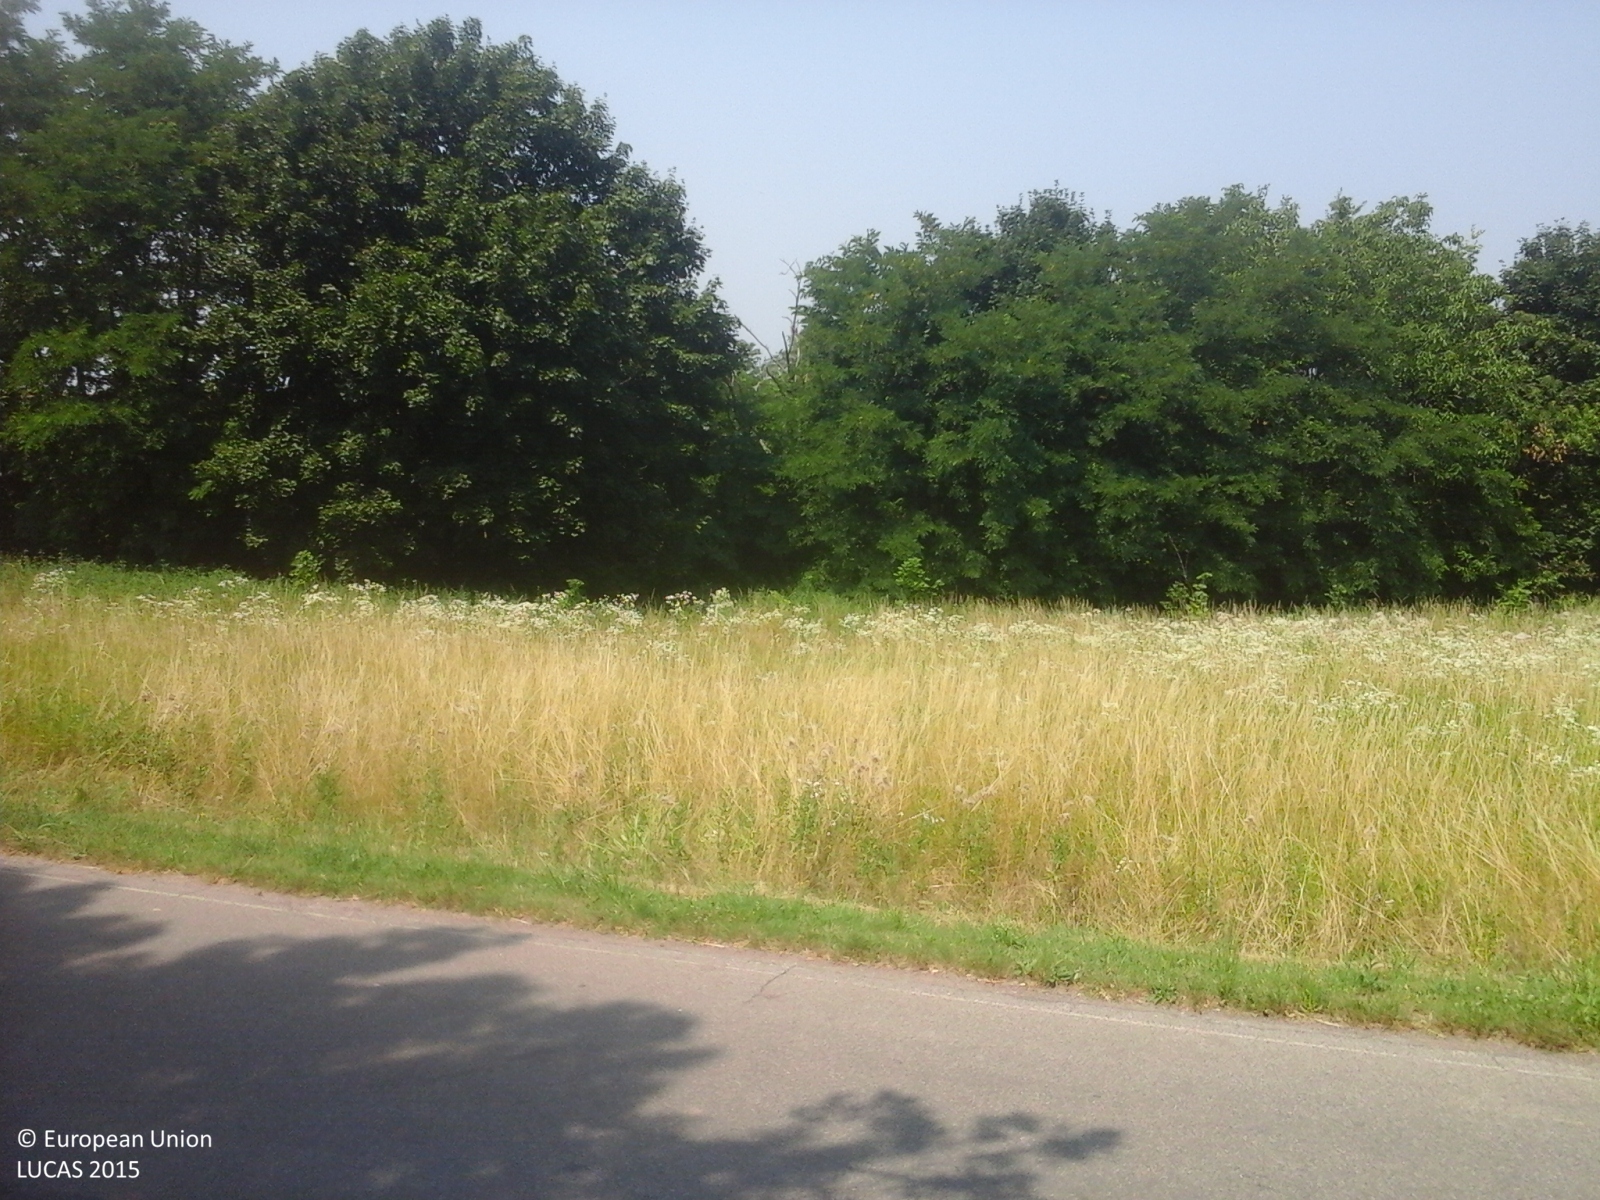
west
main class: Grassland
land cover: Grassland without tree/shrub cover
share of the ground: > 75 %
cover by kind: herbaceous plants 100 %
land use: Agriculture (excluding fallow land and kitchen gardens)
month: July
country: IT
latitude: 45.6470
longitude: 9.4236
